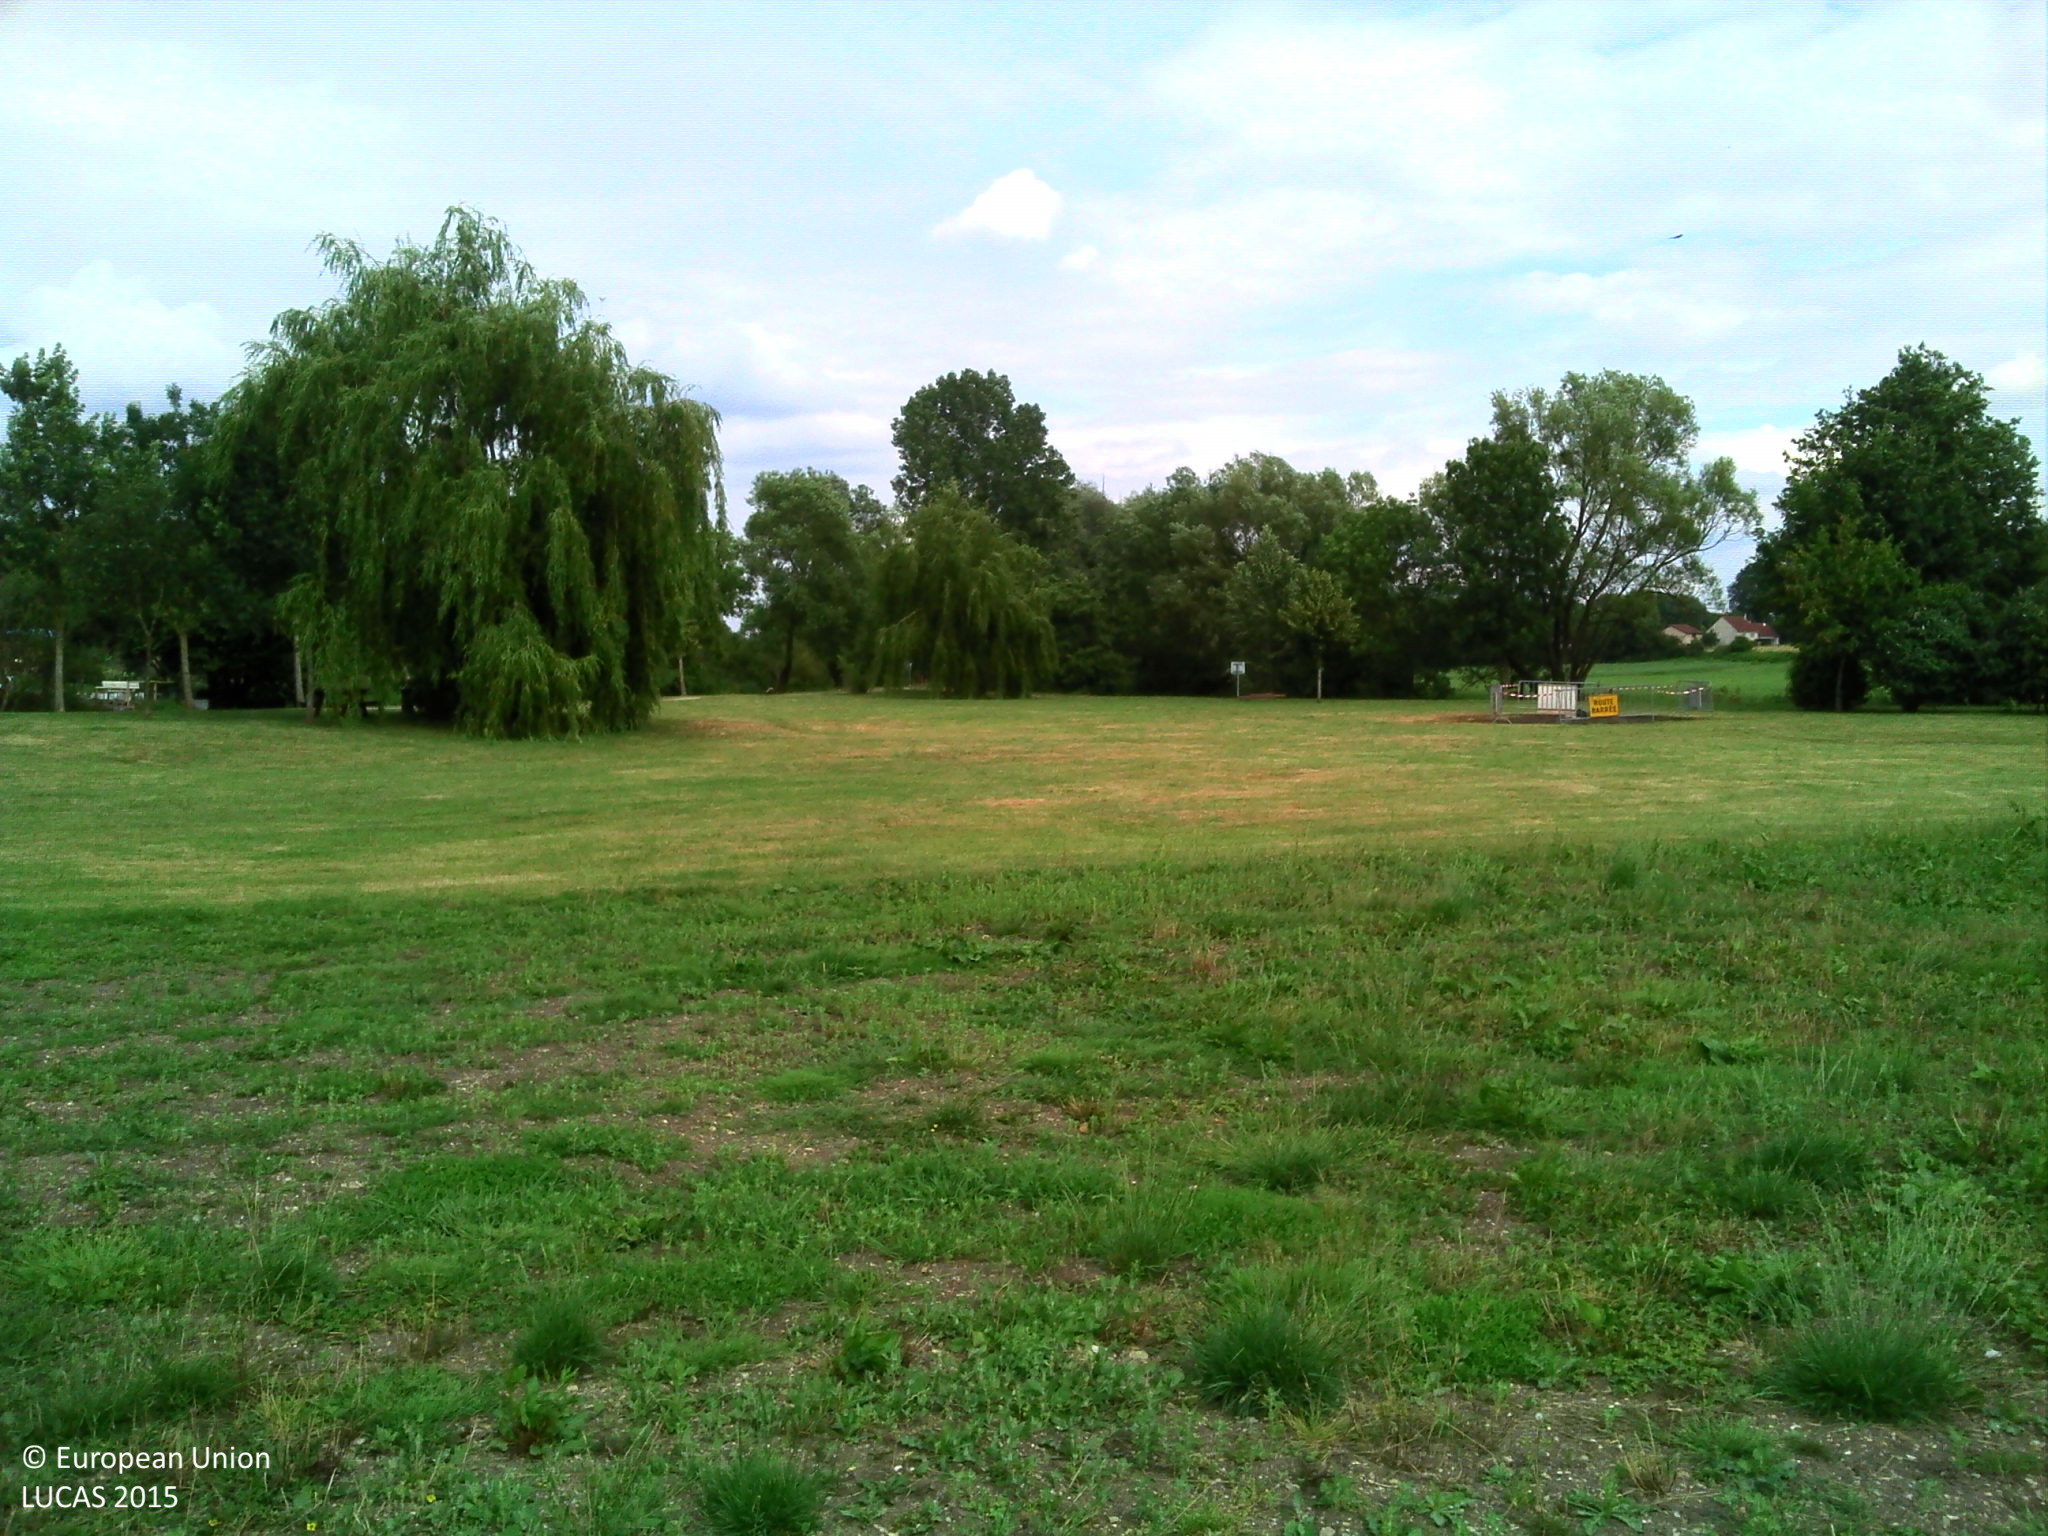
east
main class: Grassland
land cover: Spontaneously vegetated surfaces
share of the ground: > 75 %
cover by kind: herbaceous plants 100 %
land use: Amenities, museums, leisure
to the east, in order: Spontaneously vegetated surfaces; Grassland with sparse tree/shrub cover; Tracks; Grass margins; Lines of trees; Inland fresh running water; Artificial constructions in urban areas
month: June
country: FR
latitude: 48.6538
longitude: 6.4844
